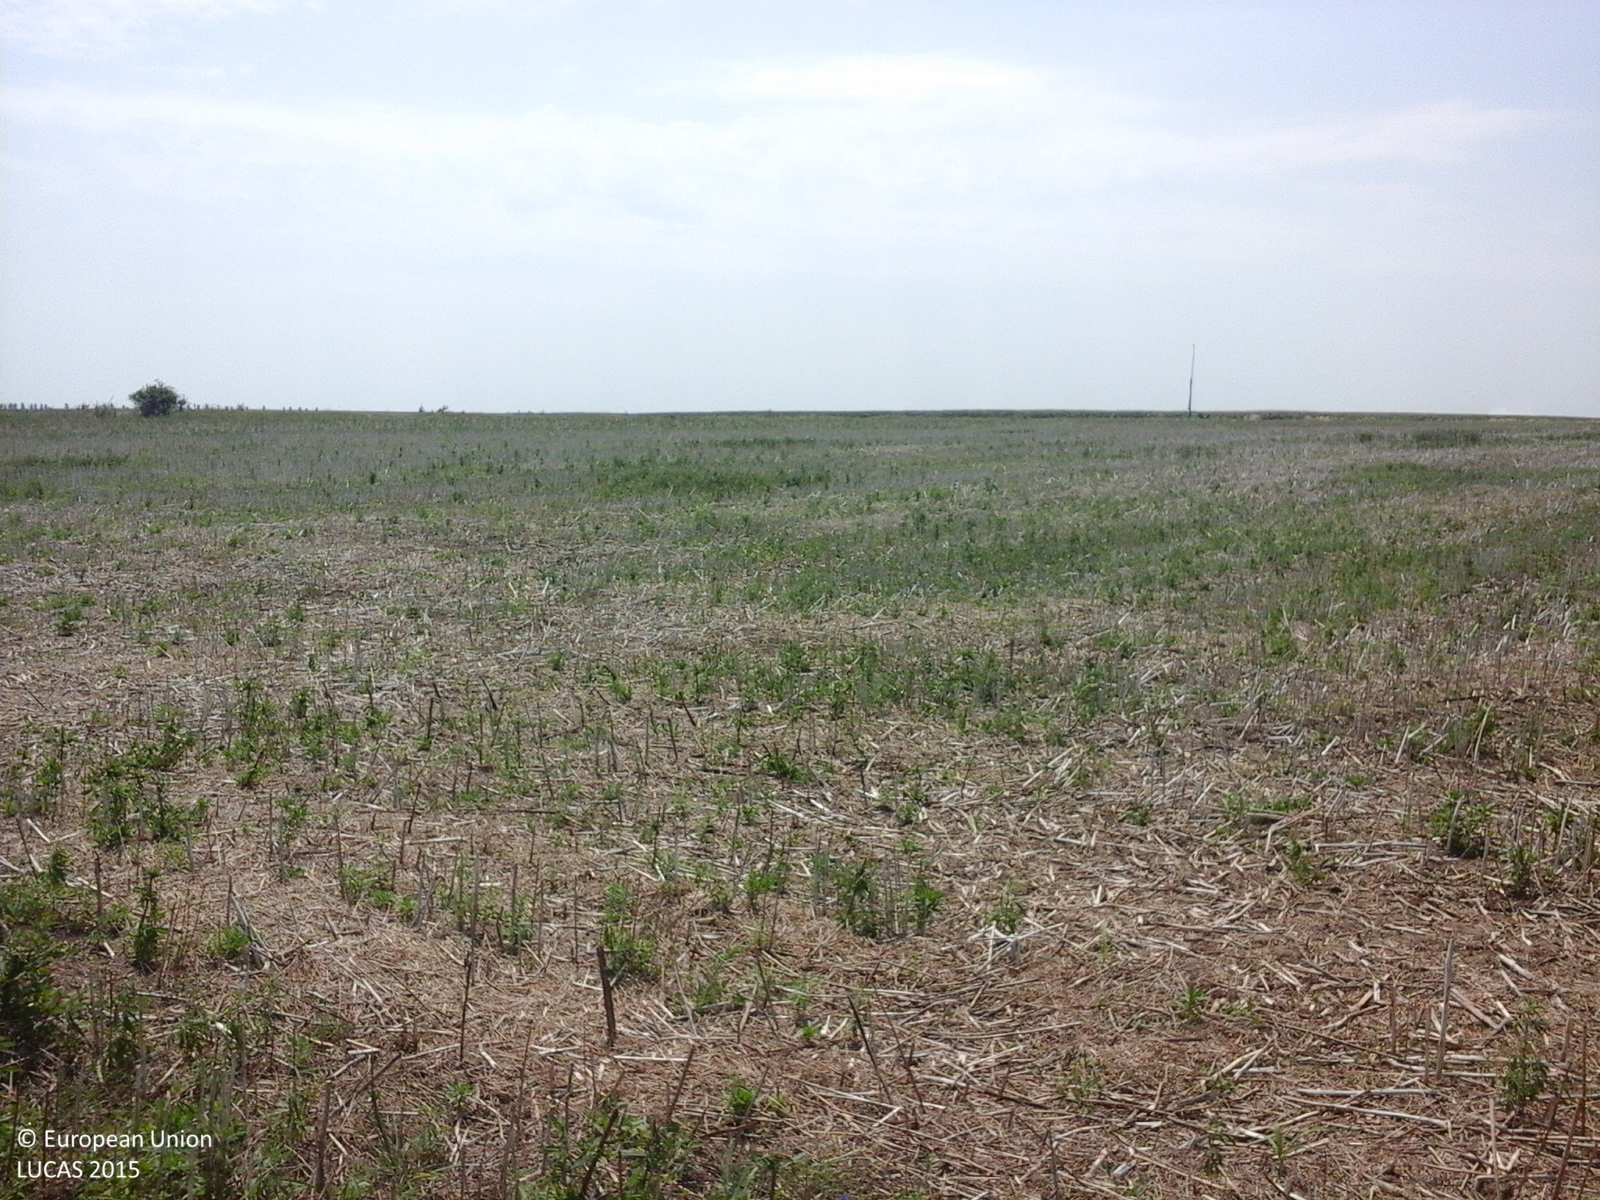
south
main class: Cropland
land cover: Maize
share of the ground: > 75 %
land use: Agriculture (excluding fallow land and kitchen gardens)
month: July
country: RO
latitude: 44.7818
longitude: 26.8478
